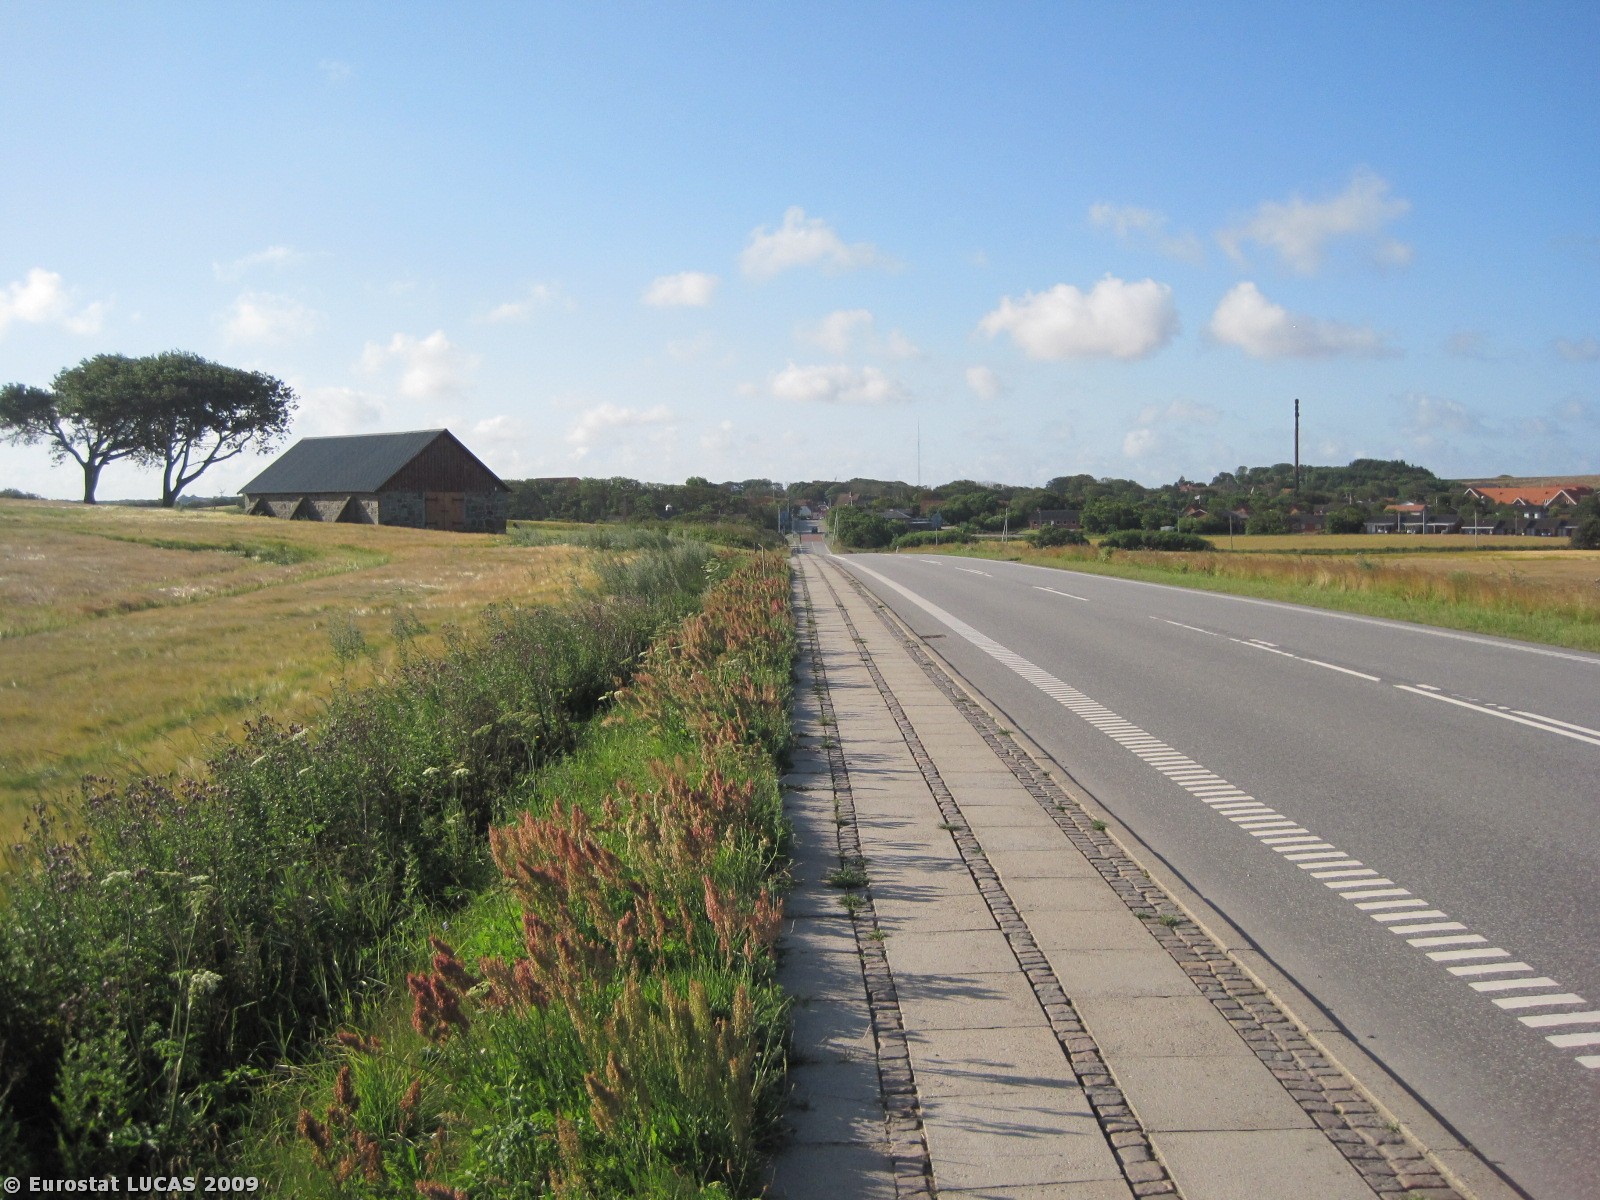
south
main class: Cropland
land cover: Barley
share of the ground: > 75 %
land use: Agriculture (excluding fallow land and kitchen gardens)
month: July
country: DK
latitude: 56.7701
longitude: 8.3170
